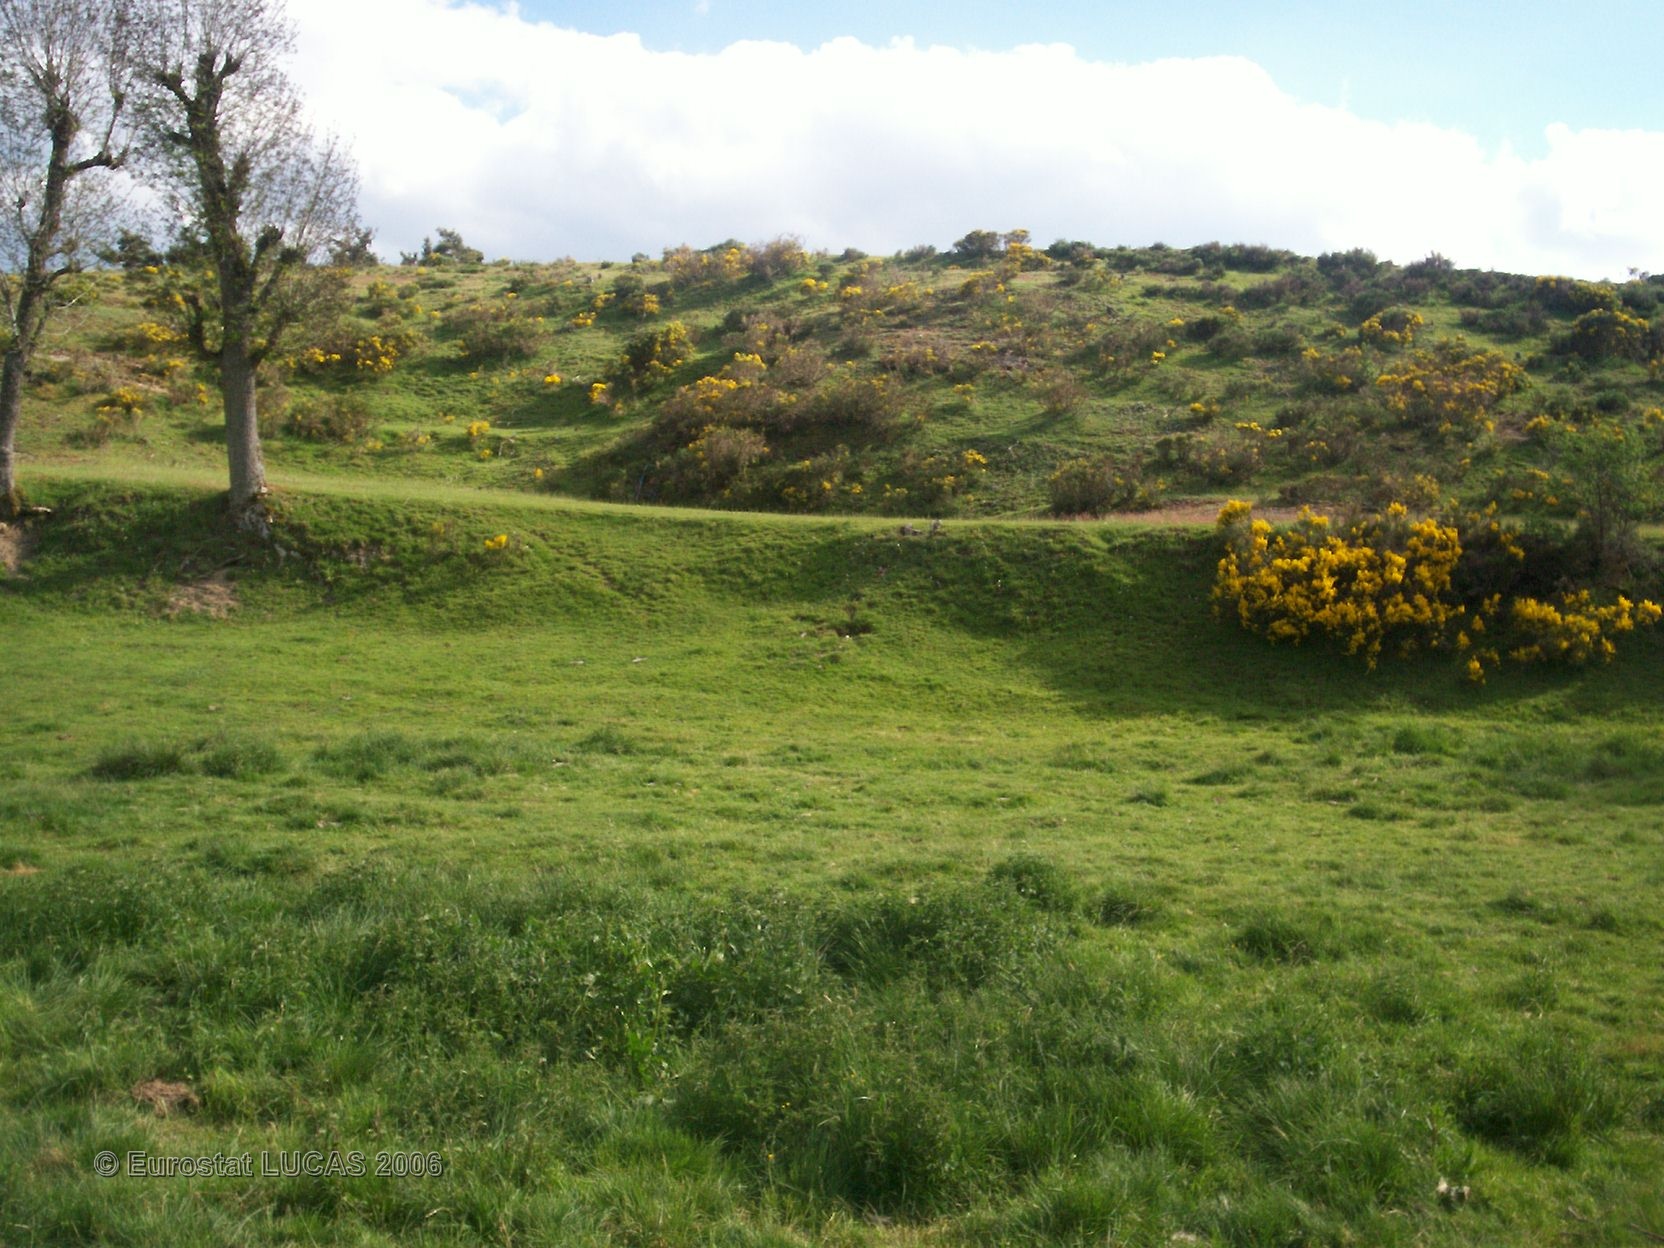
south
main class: Grassland
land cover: Grassland with sparse tree/shrub cover
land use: Agriculture (excluding fallow land and kitchen gardens)
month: May
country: FR
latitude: 44.7177
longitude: 3.3766
